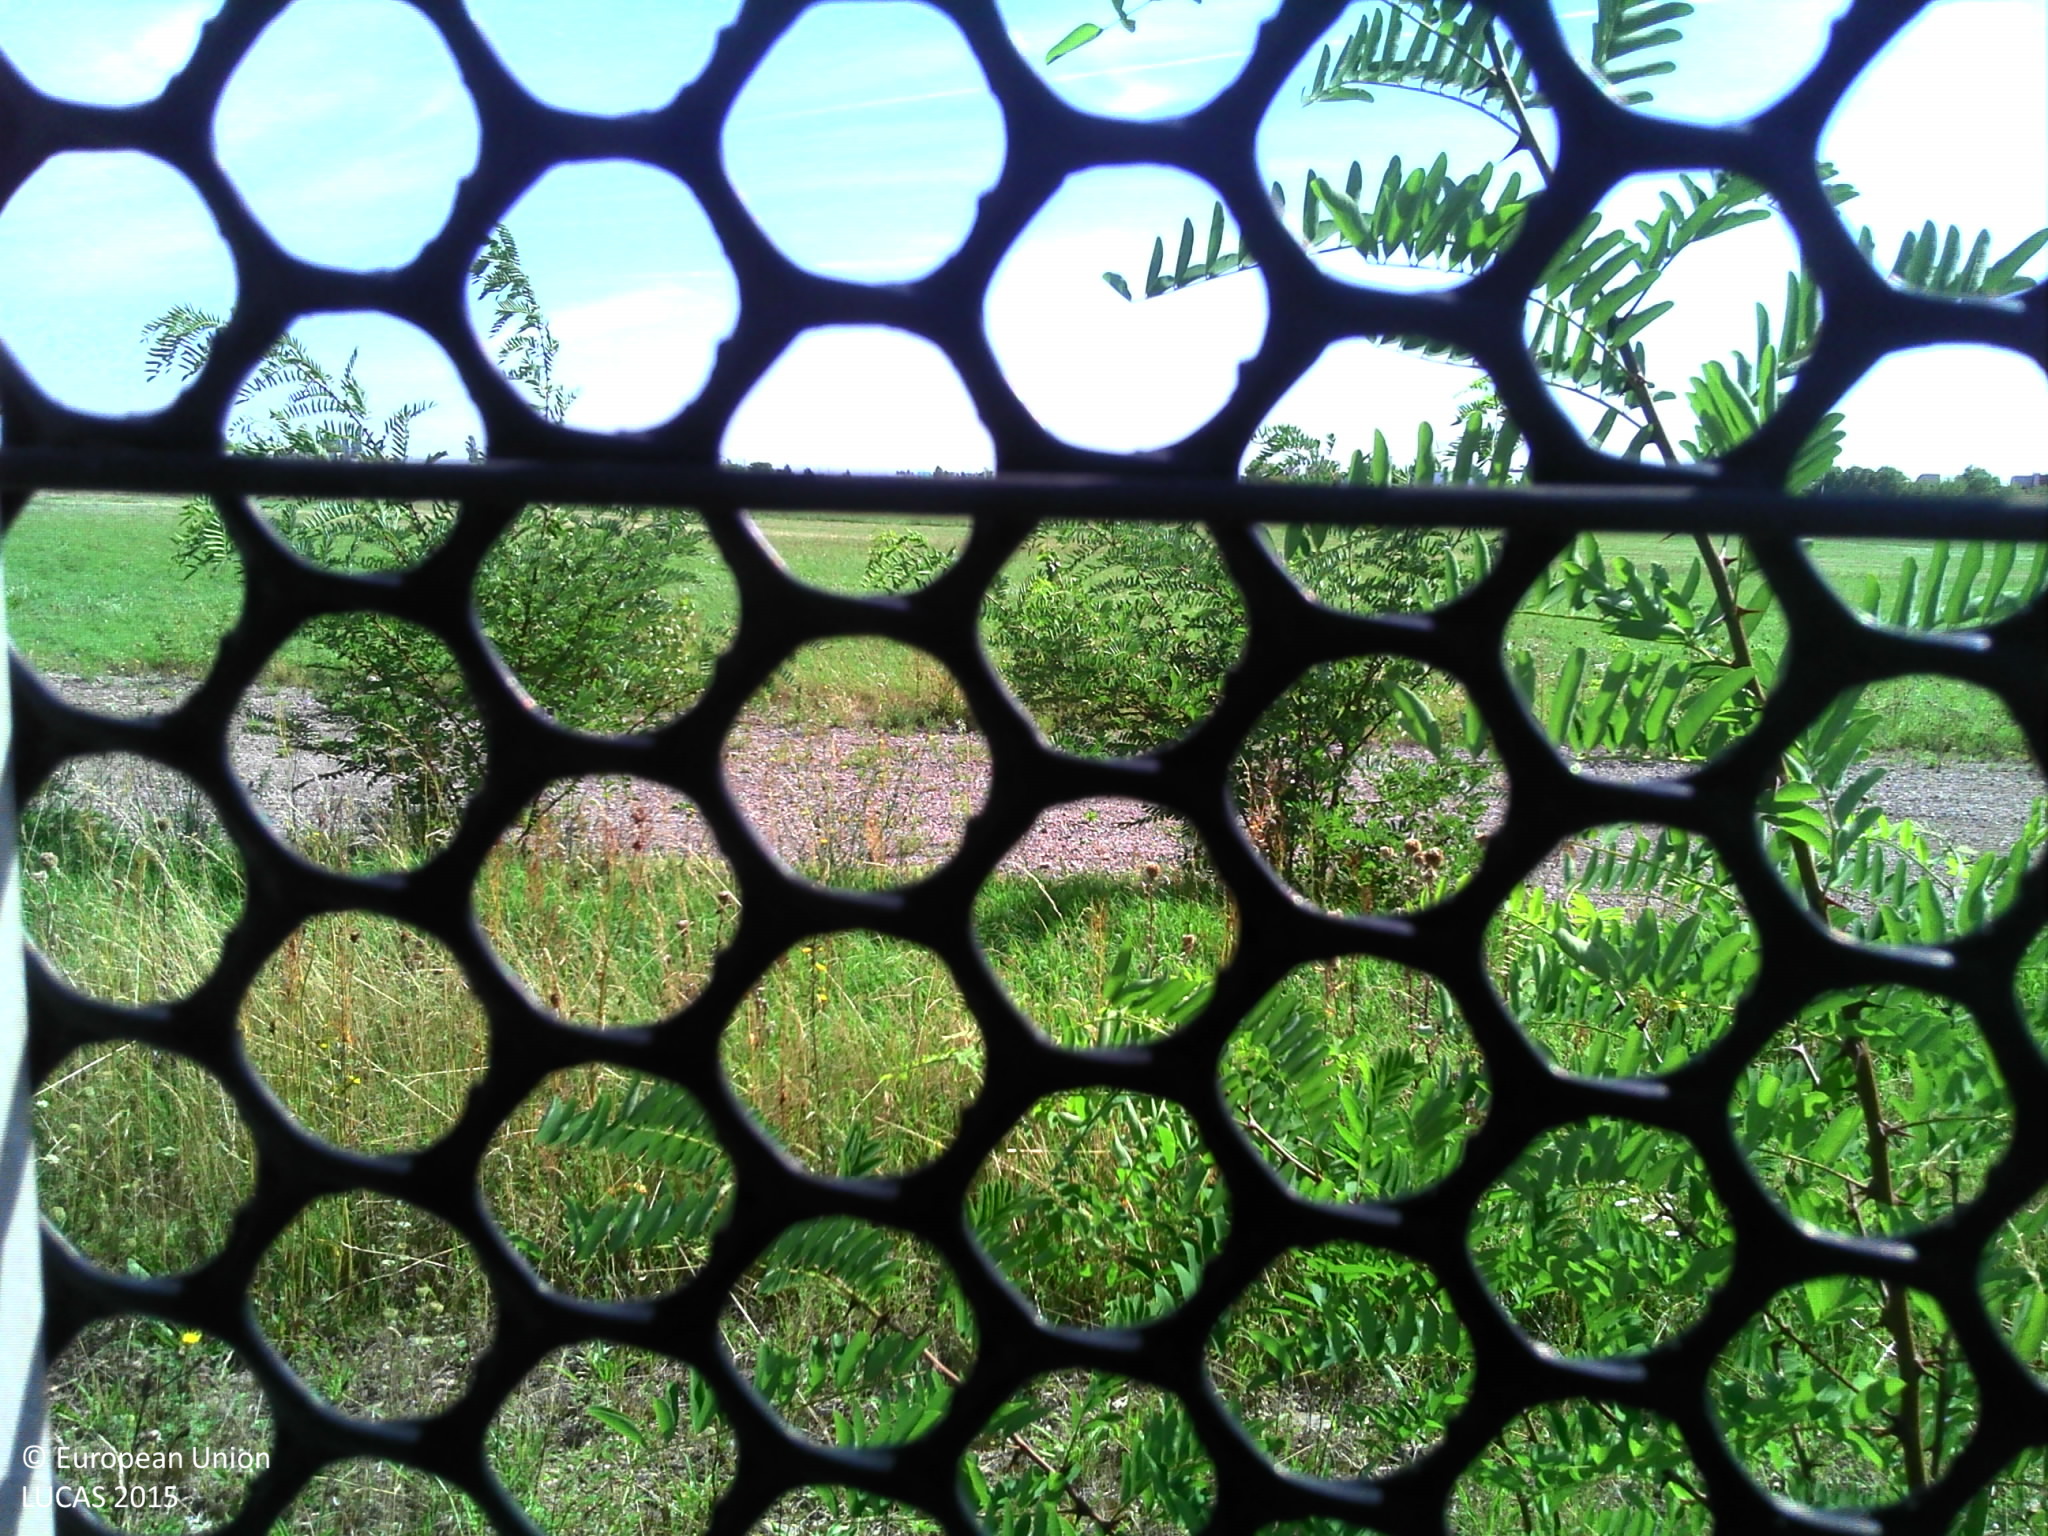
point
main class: Grassland
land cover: Grassland without tree/shrub cover
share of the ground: > 75 %
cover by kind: herbaceous plants 100 %
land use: Air transport
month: August
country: FR
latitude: 48.1018
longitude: 7.3556
